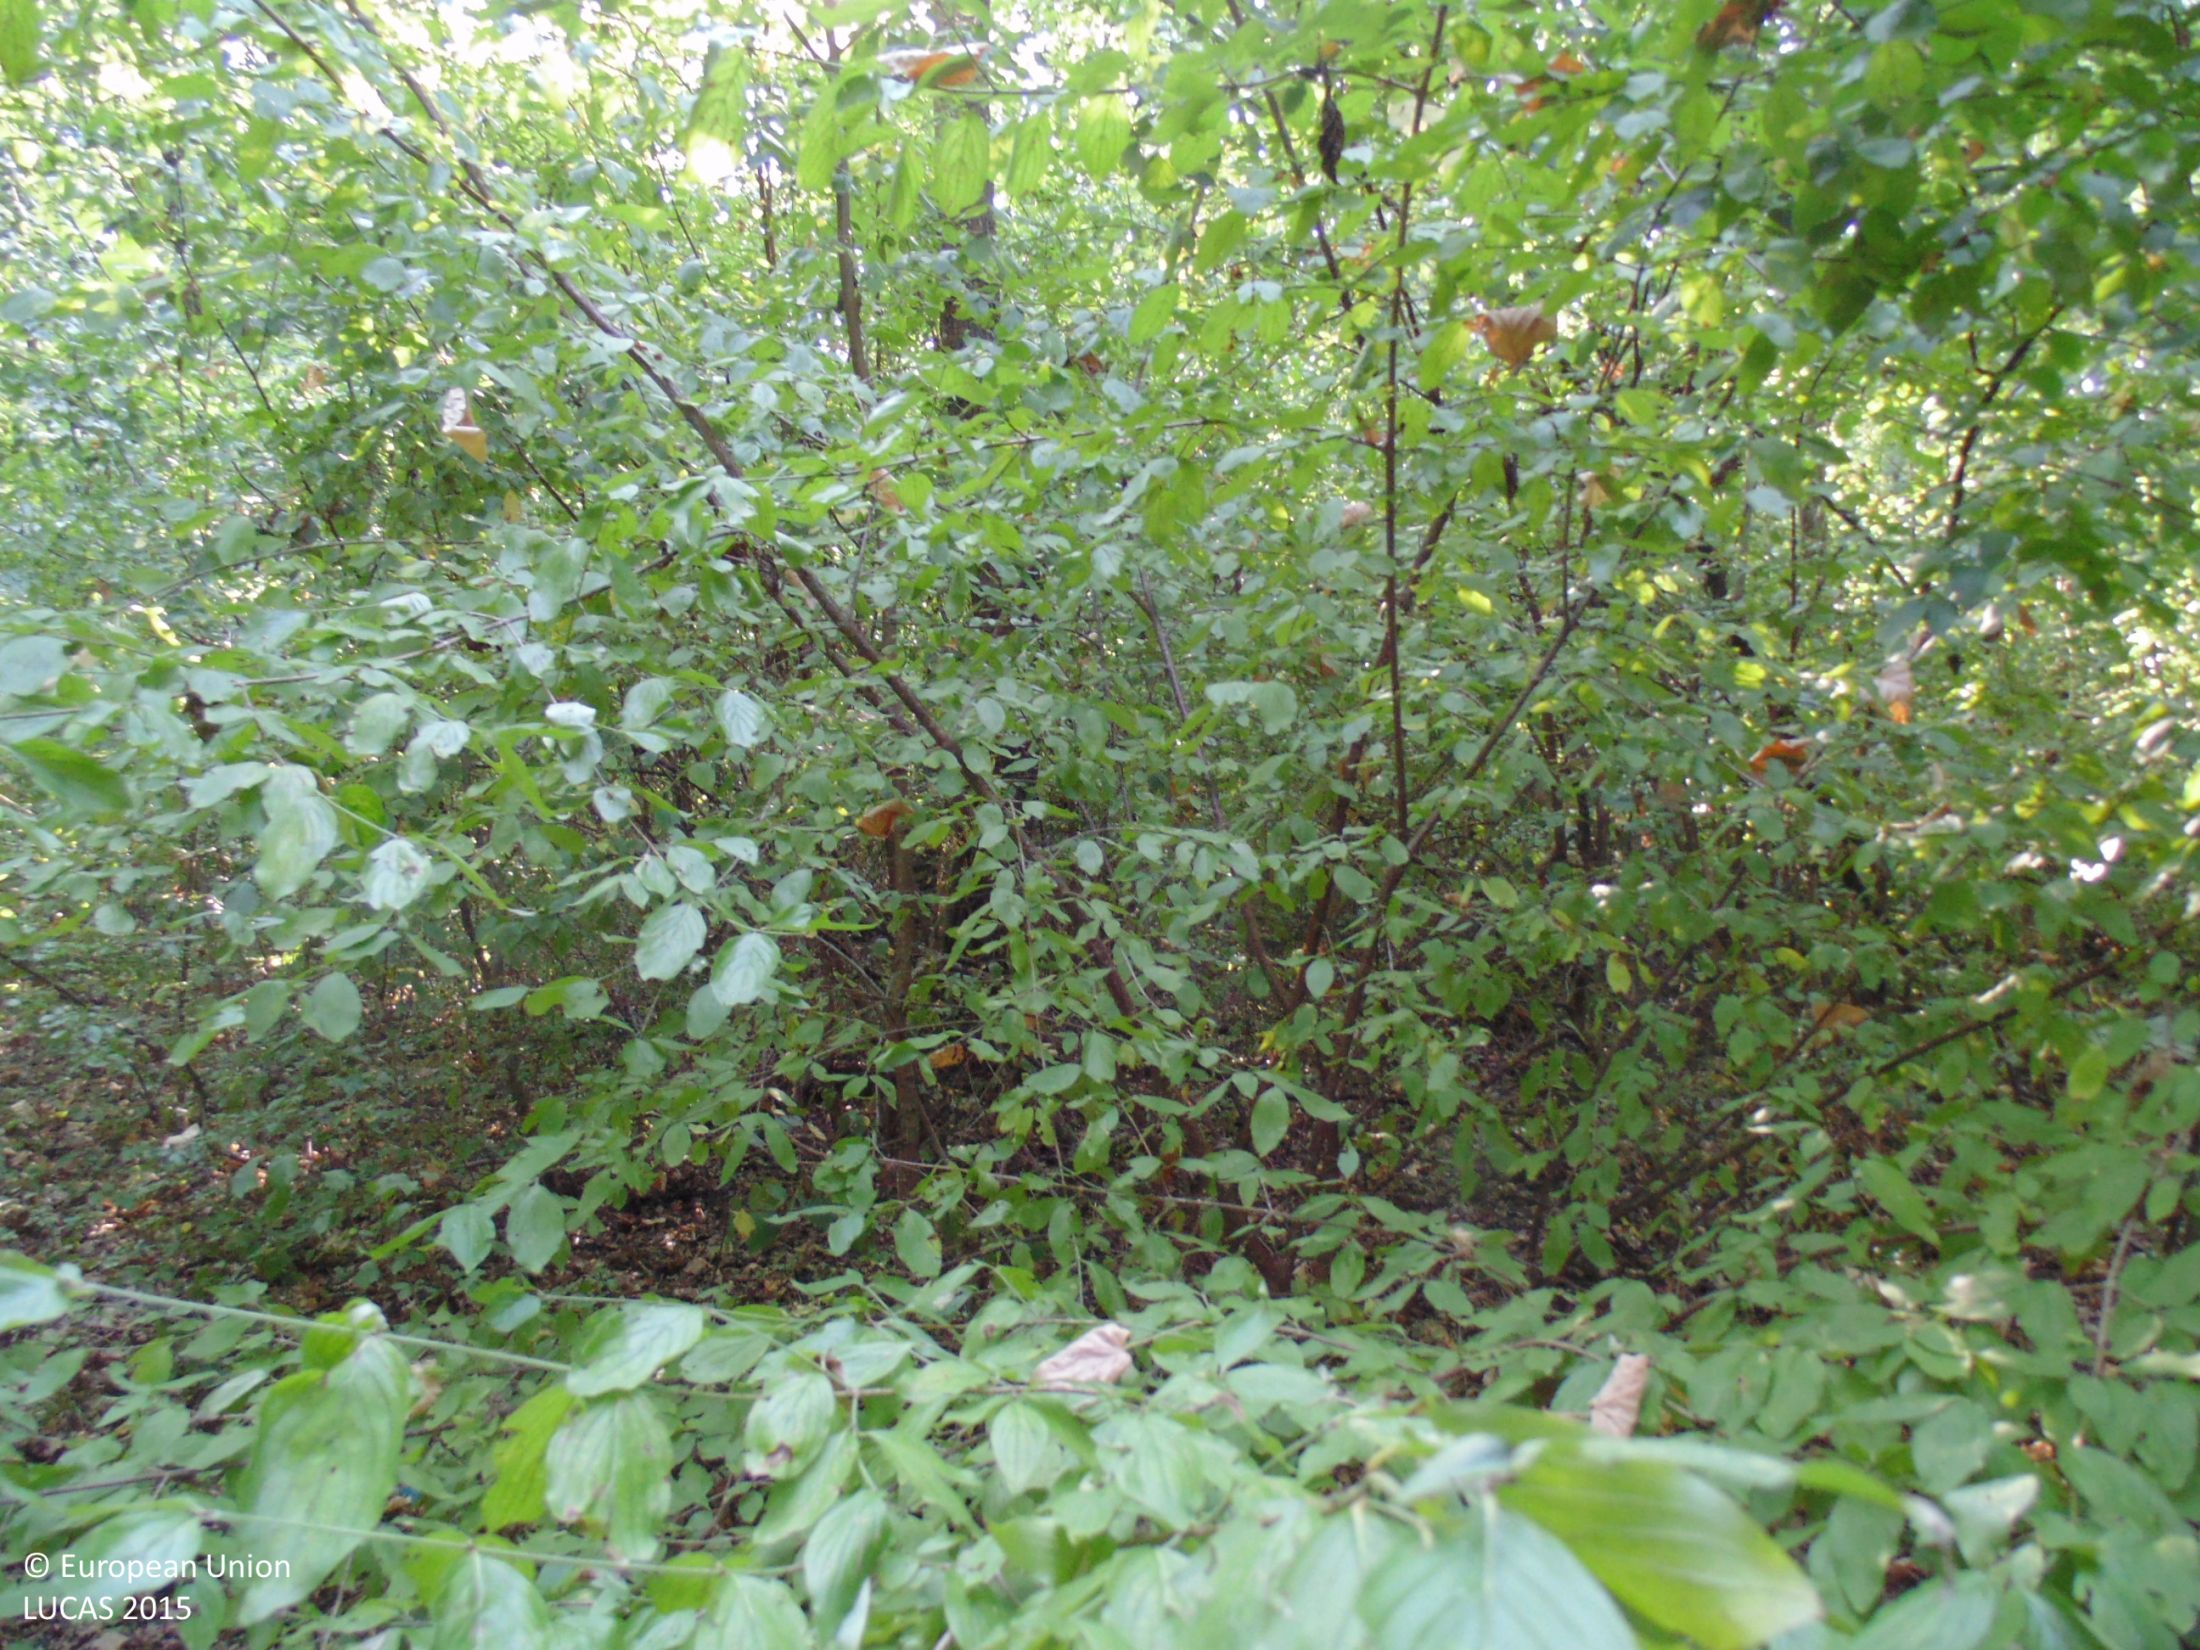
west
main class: Woodland
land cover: Broadleaved woodland
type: mesophytic deciduous forest
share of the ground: > 75 %
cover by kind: broadleaved forest trees 90 %, shrubs 5 %, unconsolidated bare surface 5 %
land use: Forestry
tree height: > 5 m
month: September
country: BG
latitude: 43.8534
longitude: 26.9009
